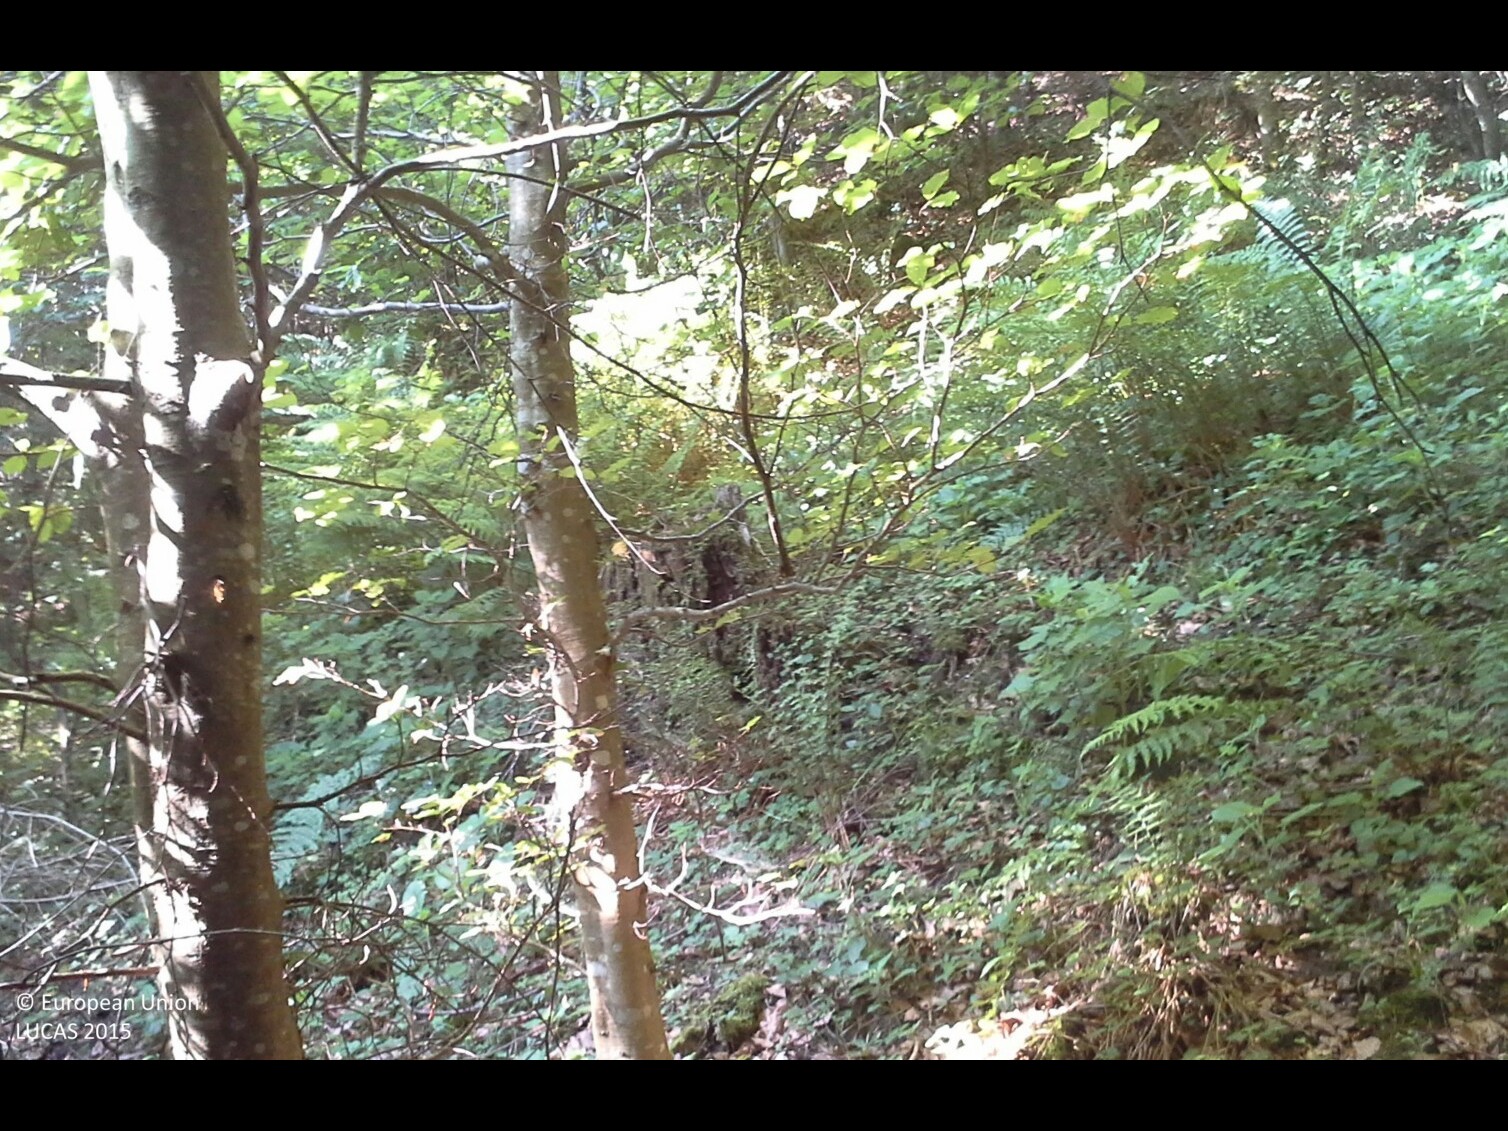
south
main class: Woodland
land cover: Spruce dominated mixed woodland
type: mountainous beech forest
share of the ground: > 75 %
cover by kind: coniferous forest trees 55 %, broadleaved forest trees 35 %, herbaceous plants 10 %
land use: Forestry
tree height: > 5 m
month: June
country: AT
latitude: 47.8443
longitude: 14.4762
